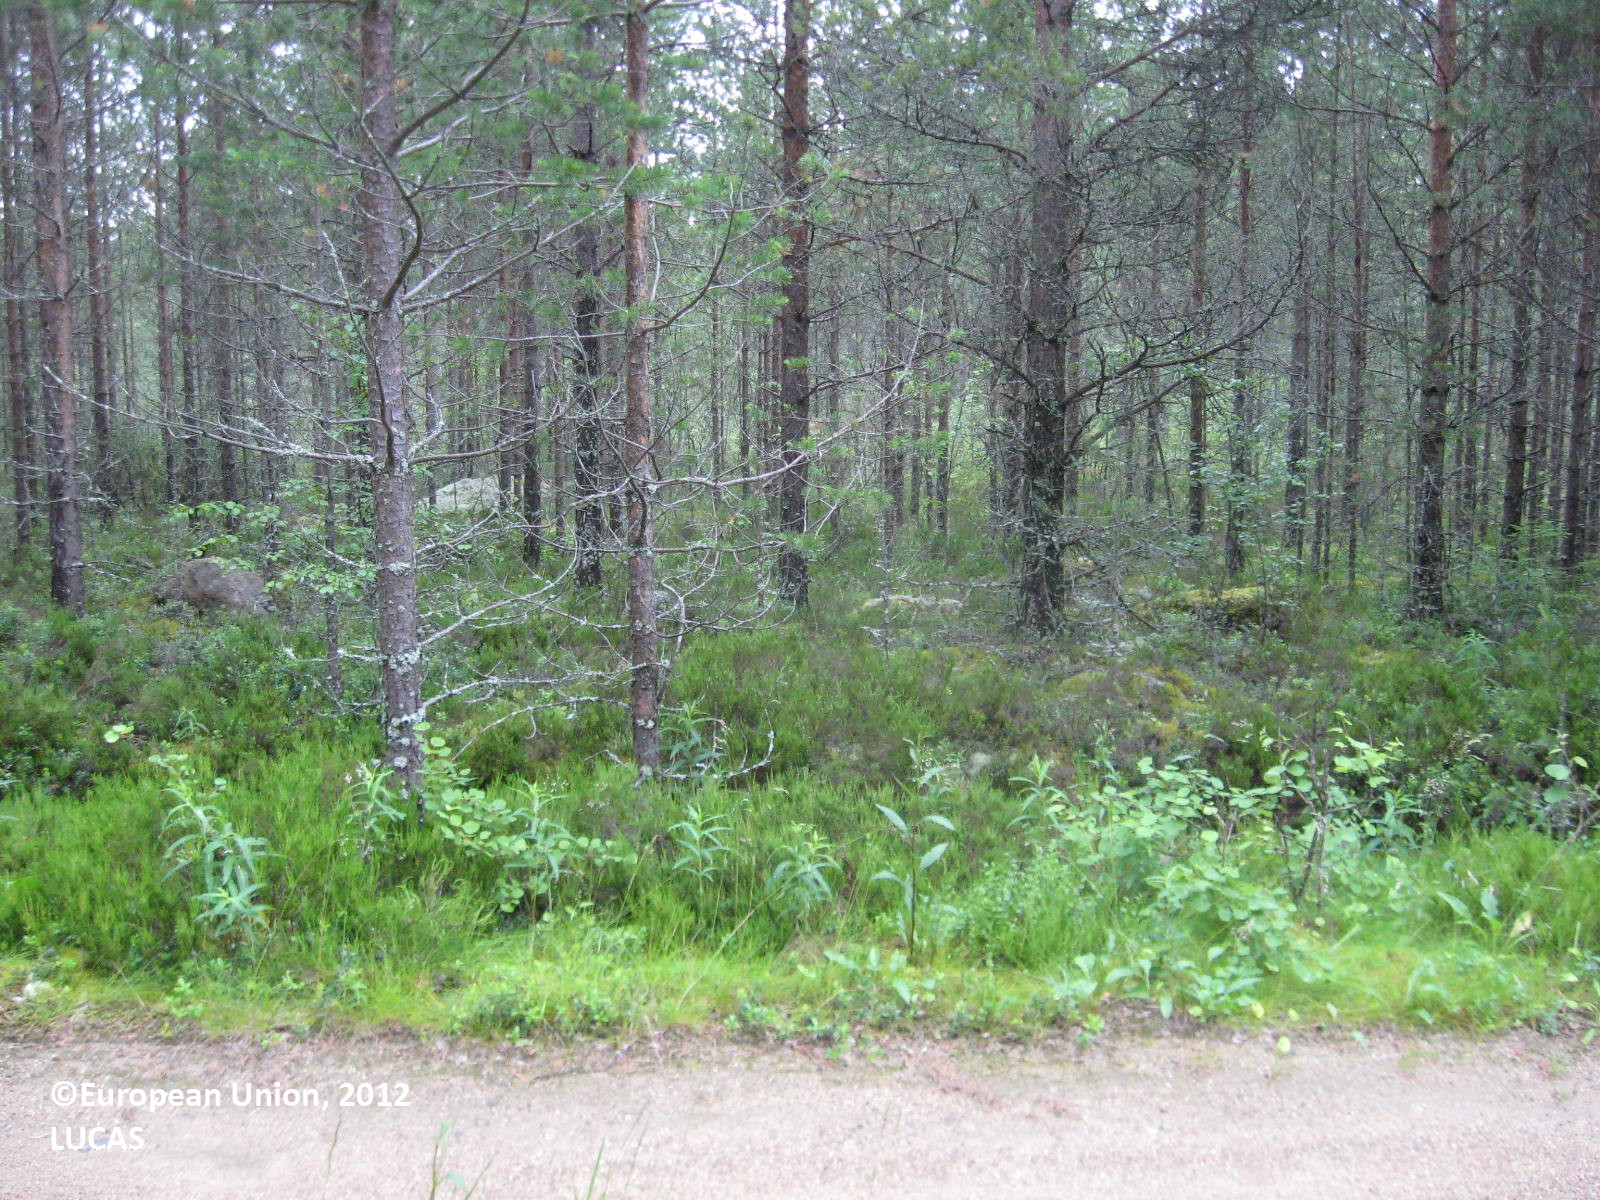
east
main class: Woodland
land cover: Pine dominated coniferous woodland
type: boreal forest
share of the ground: > 75 %
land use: Forestry
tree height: > 5 m
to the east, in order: Pine dominated coniferous woodland; Paved roads, cycling and walking lanes; Pine dominated coniferous woodland; Ditches and canals; Pine dominated coniferous woodland
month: July
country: FI
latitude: 62.3473
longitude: 22.4755
